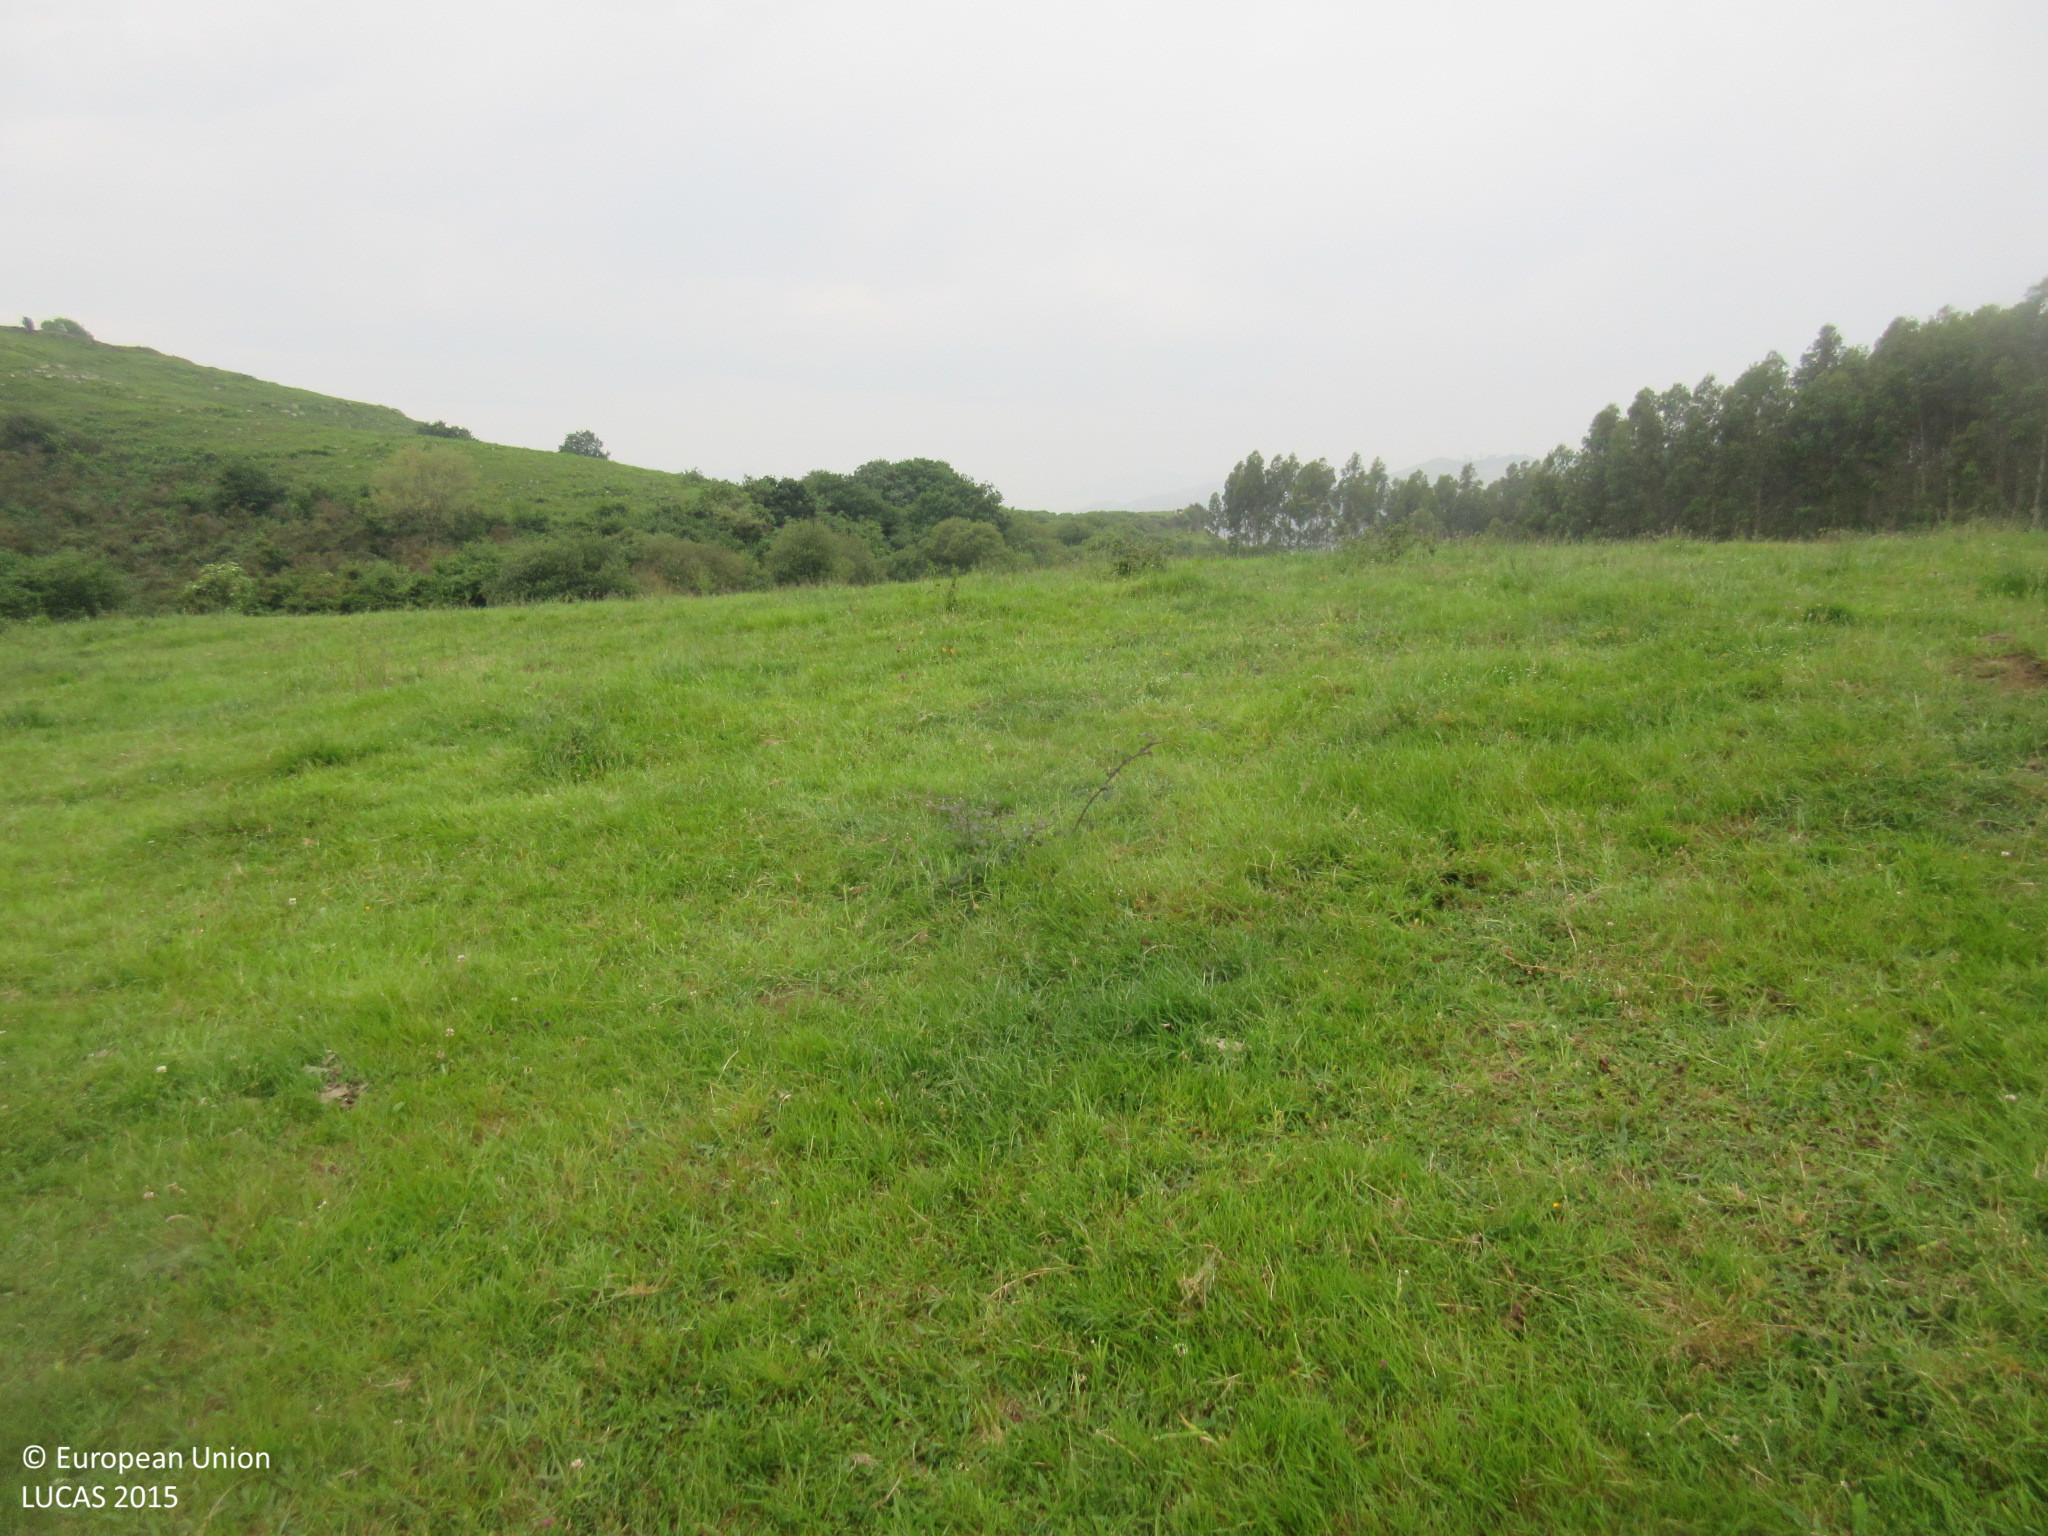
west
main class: Grassland
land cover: Grassland without tree/shrub cover
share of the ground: > 75 %
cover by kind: herbaceous plants 100 %
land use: Agriculture (excluding fallow land and kitchen gardens)
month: June
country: ES
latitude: 43.3737
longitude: -4.1610
